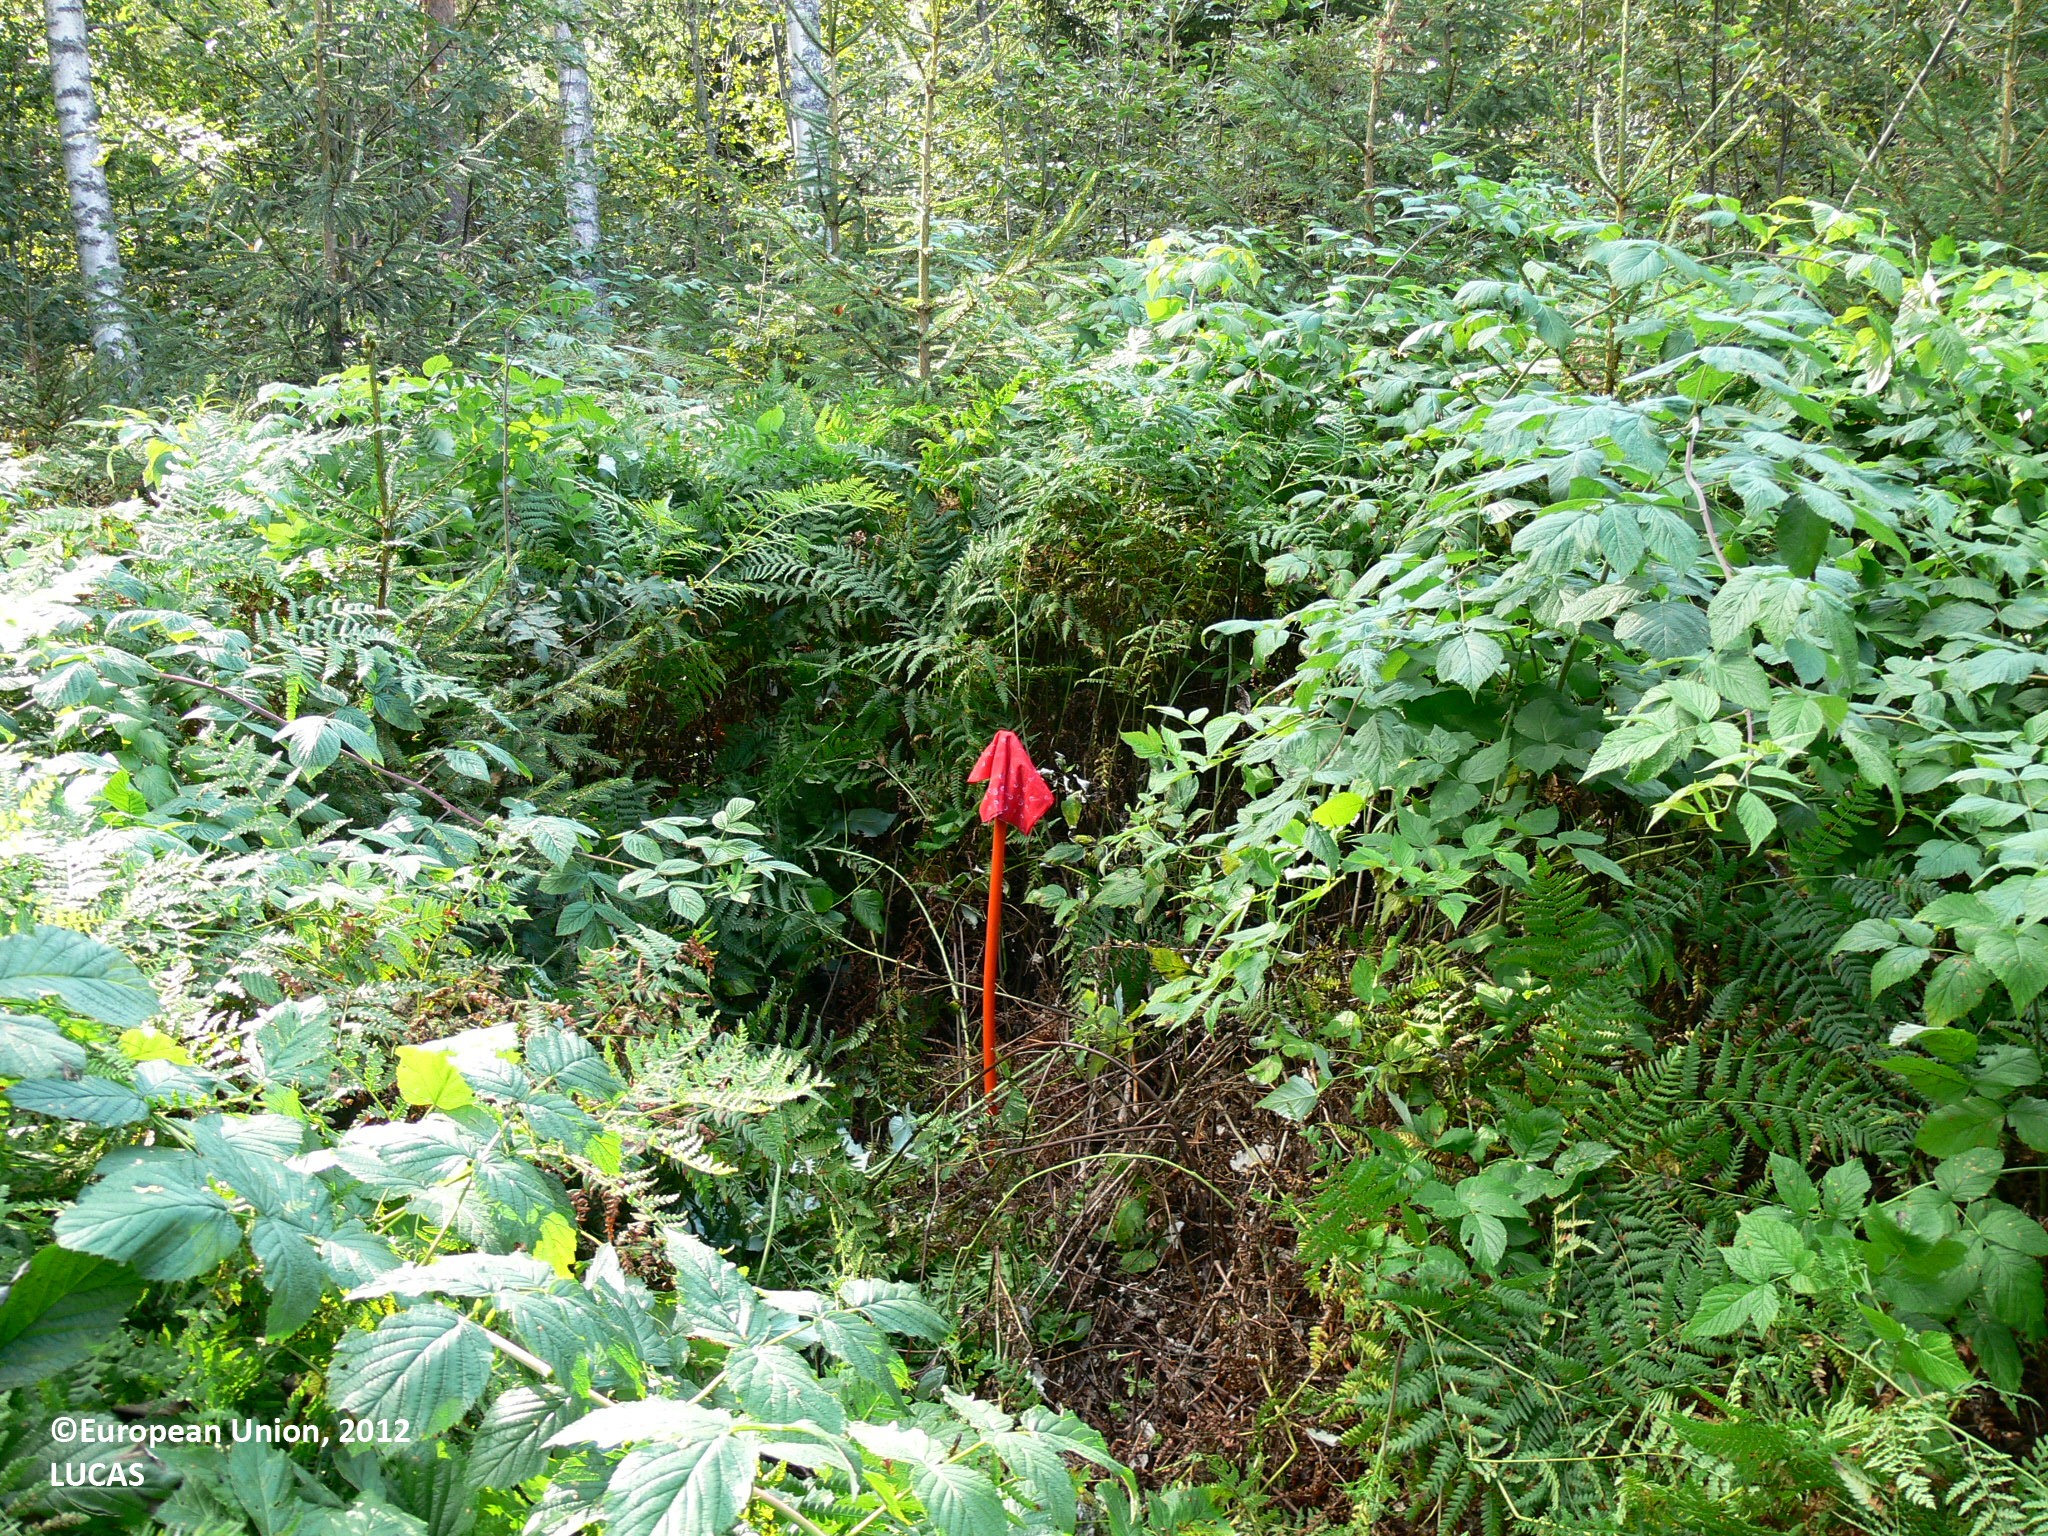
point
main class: Woodland
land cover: Spruce dominated coniferous woodland
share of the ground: 10 - 25 %
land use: Forestry
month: August
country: FI
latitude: 62.0469
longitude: 30.3008
